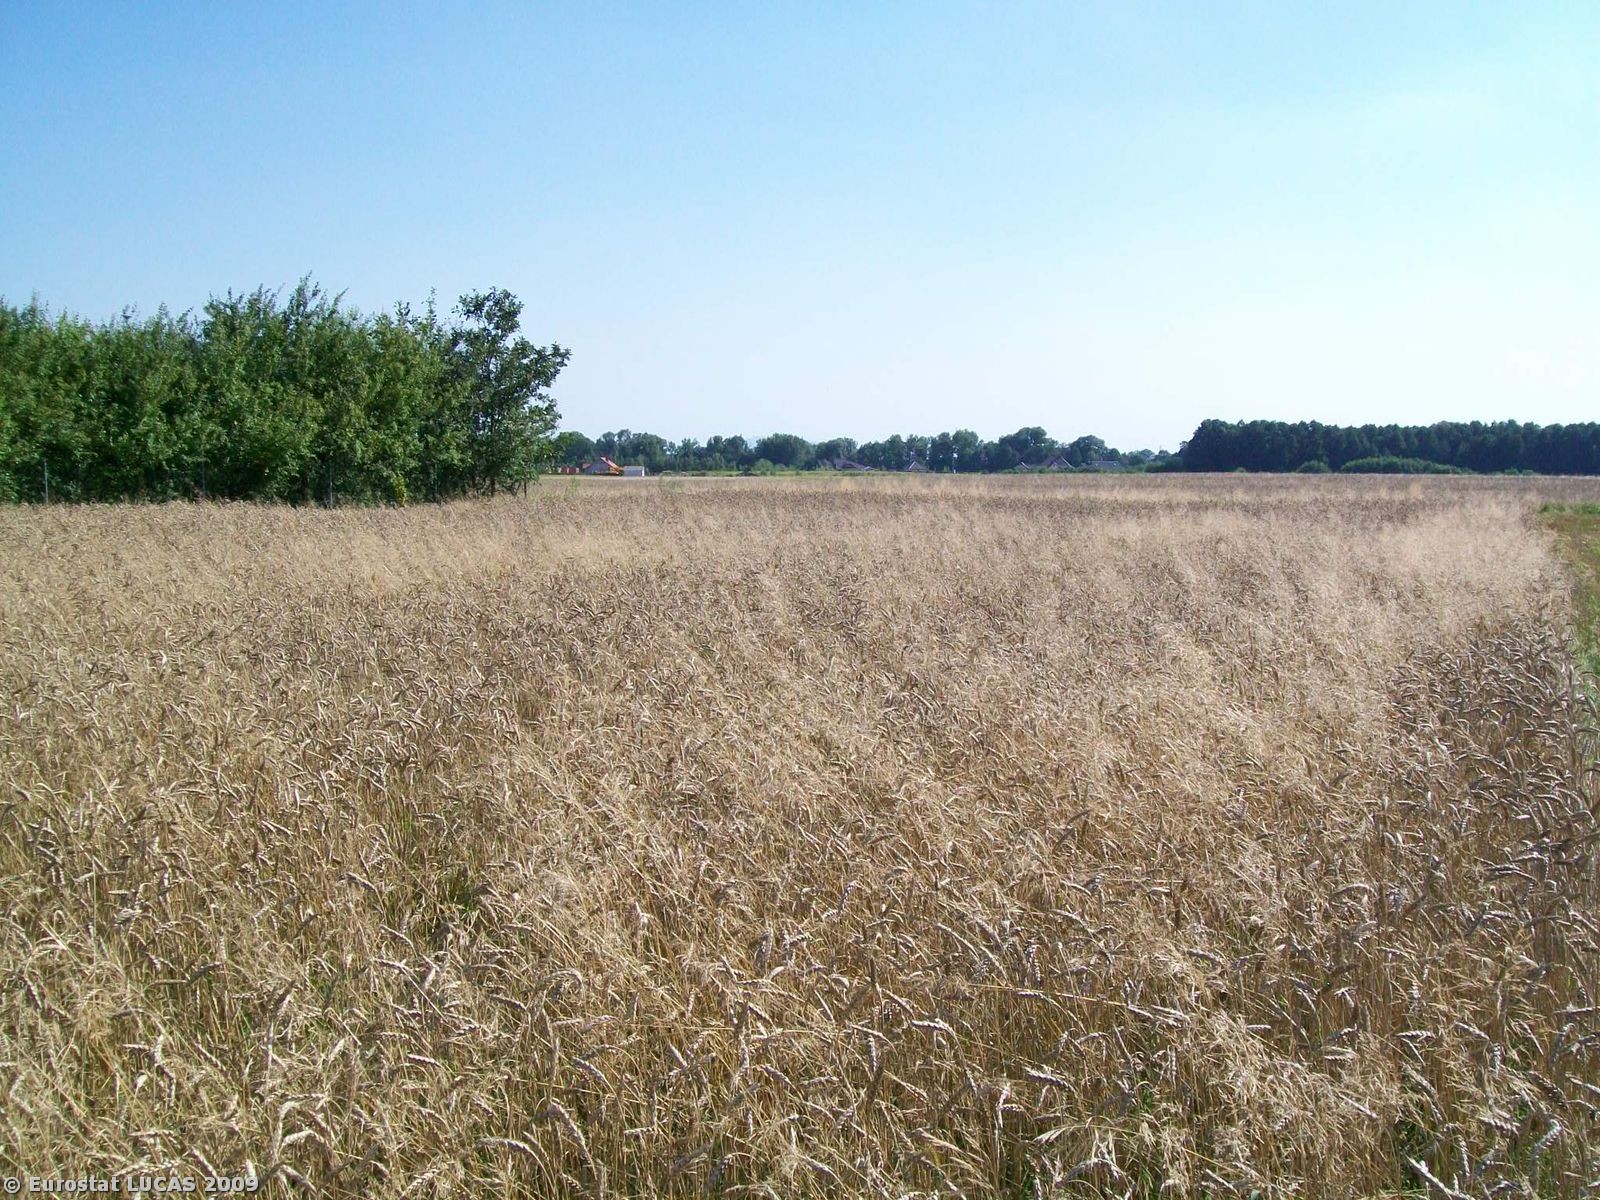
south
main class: Cropland
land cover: Common wheat
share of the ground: > 75 %
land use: Agriculture (excluding fallow land and kitchen gardens)
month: August
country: PL
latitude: 51.0842
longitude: 16.7614
